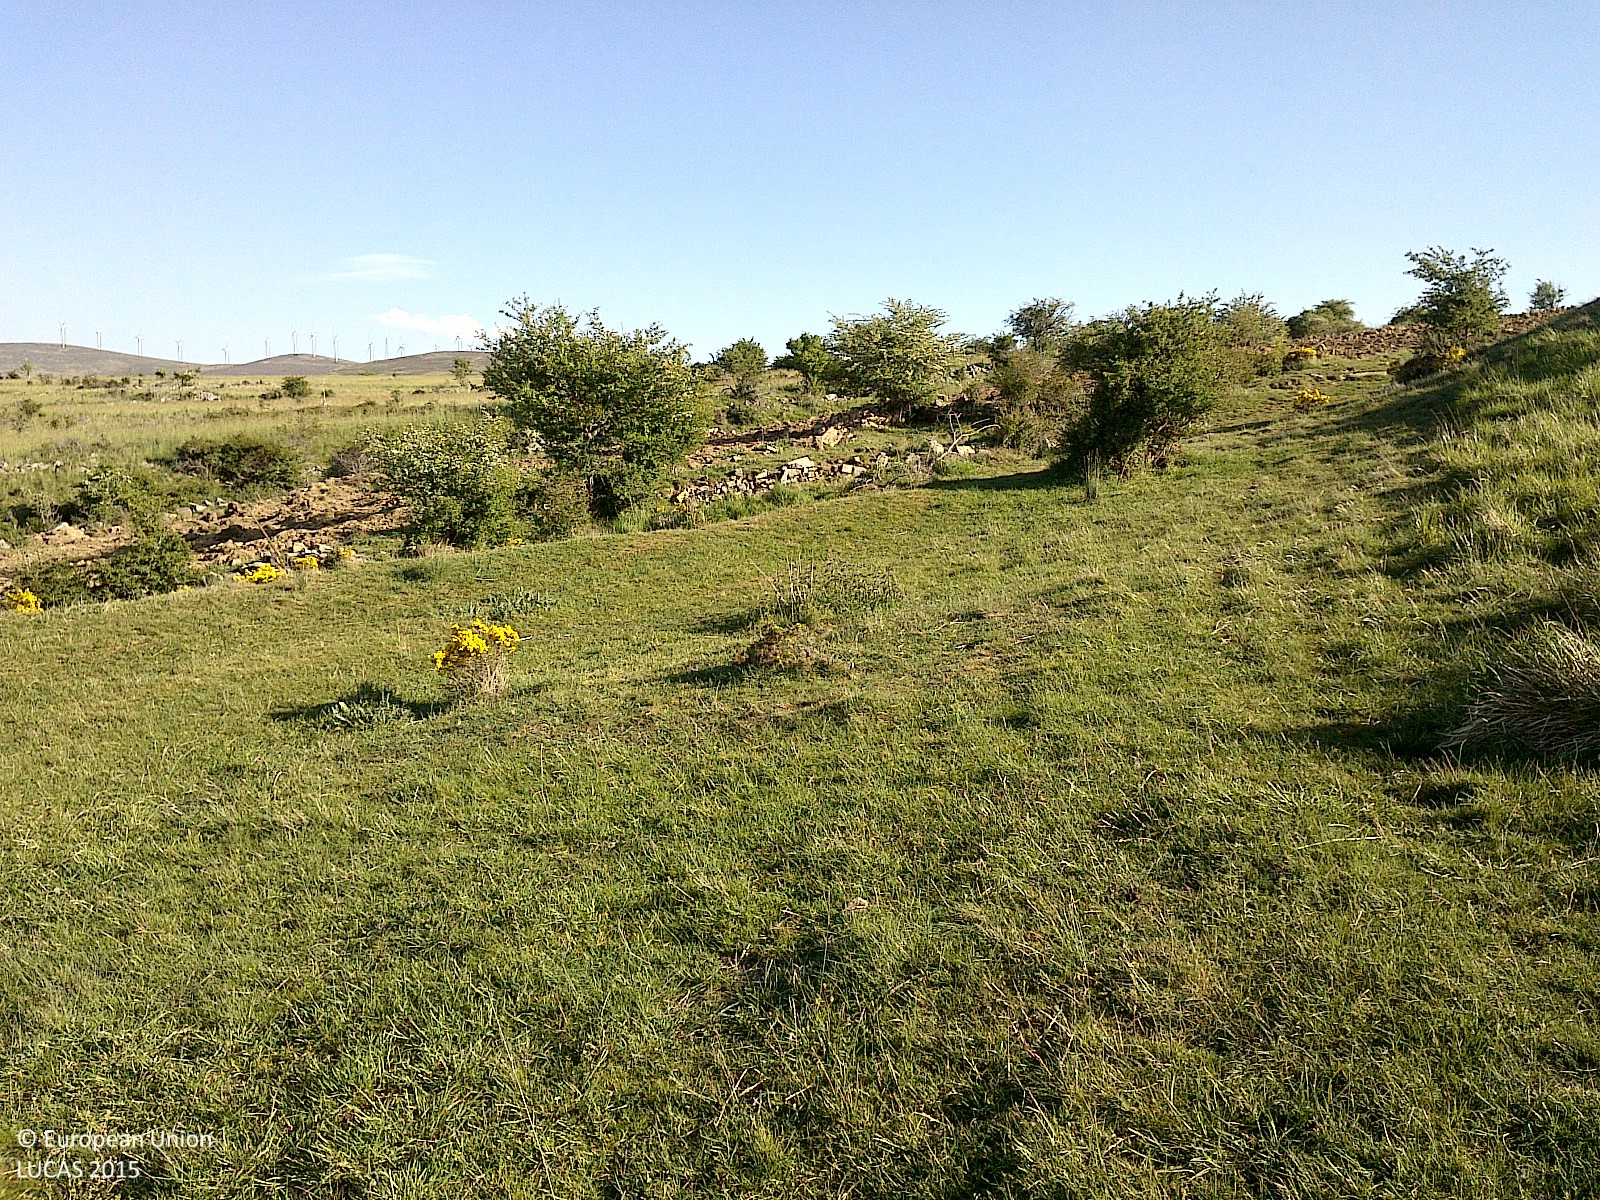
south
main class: Grassland
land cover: Grassland with sparse tree/shrub cover
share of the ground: 50 - 75 %
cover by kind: herbaceous plants 65 %, consolidated bare surface 25 %, broadleaved forest trees 5 %, shrubs 5 %
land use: Agriculture (excluding fallow land and kitchen gardens)
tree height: < 5 m
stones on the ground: < 10 %
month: May
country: ES
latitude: 42.0233
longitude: -2.3459
